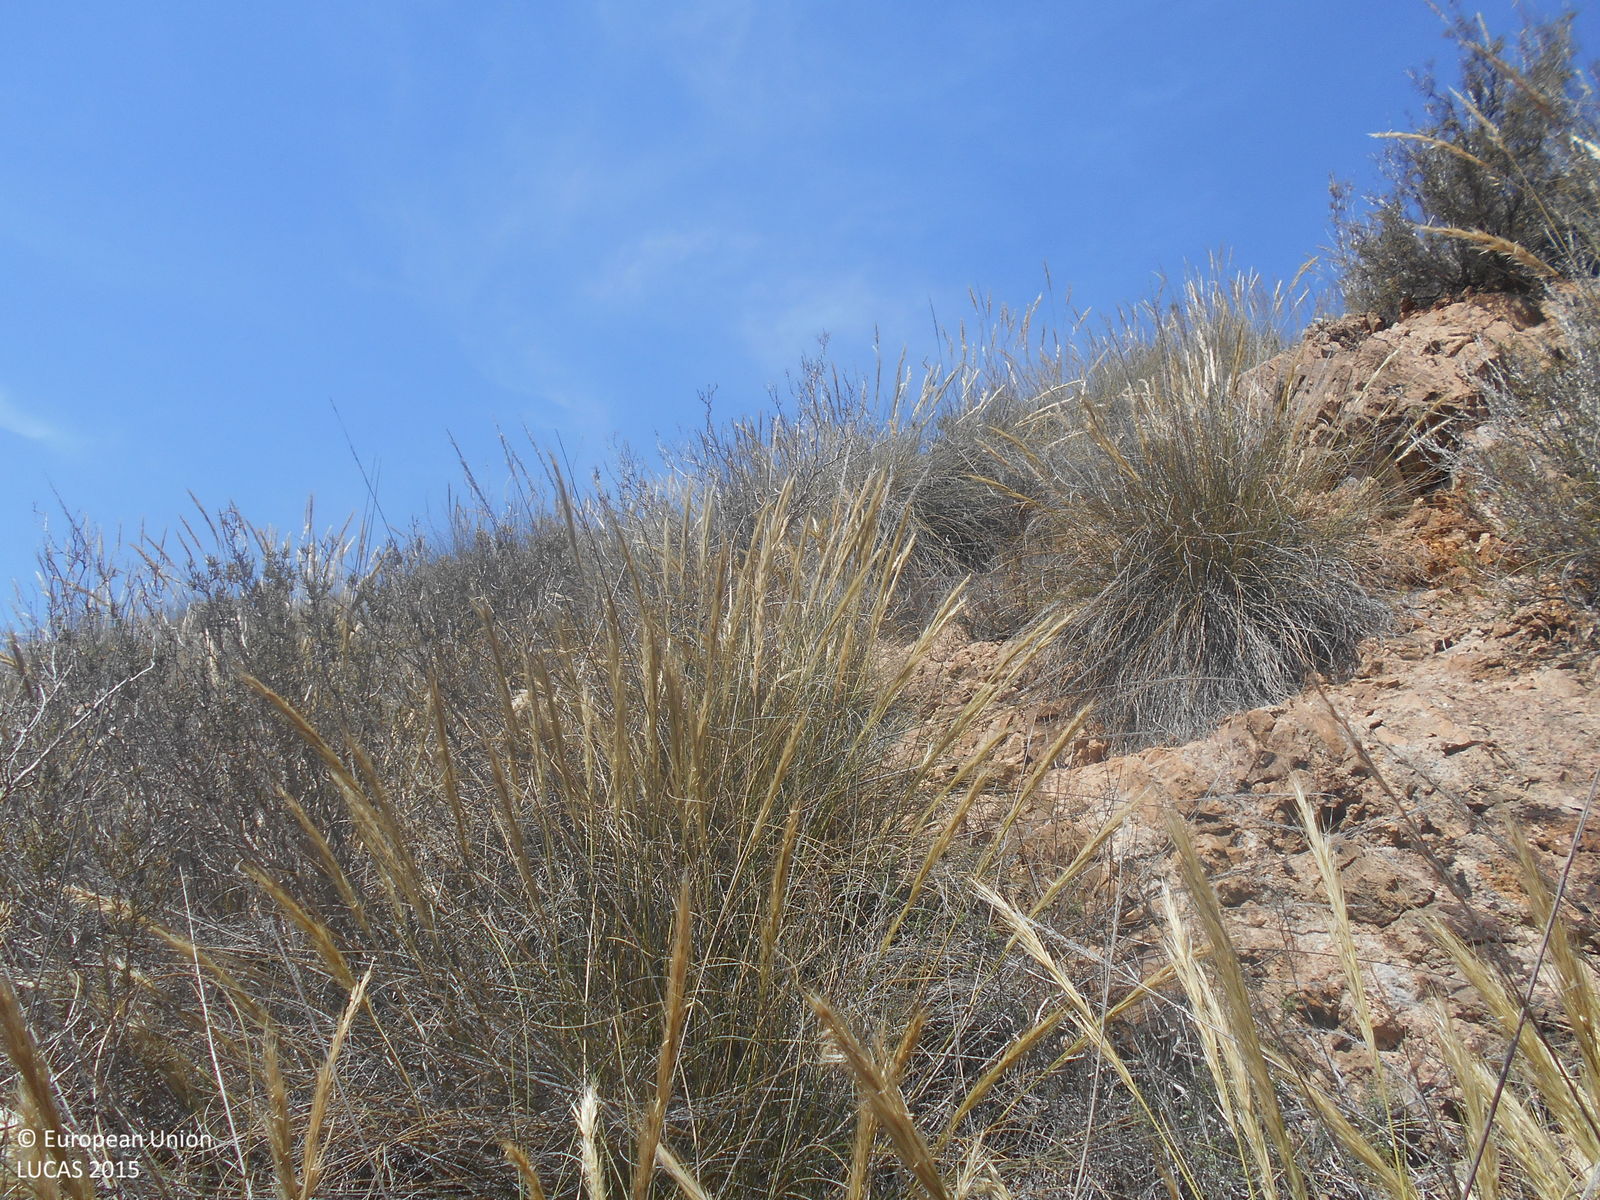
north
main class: Shrubland
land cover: Shrubland without tree cover
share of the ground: > 75 %
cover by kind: shrubs 90 %, unconsolidated bare surface 10 %
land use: Semi-natural and natural areas not in use
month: May
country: ES
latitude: 37.6387
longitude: -1.3014
